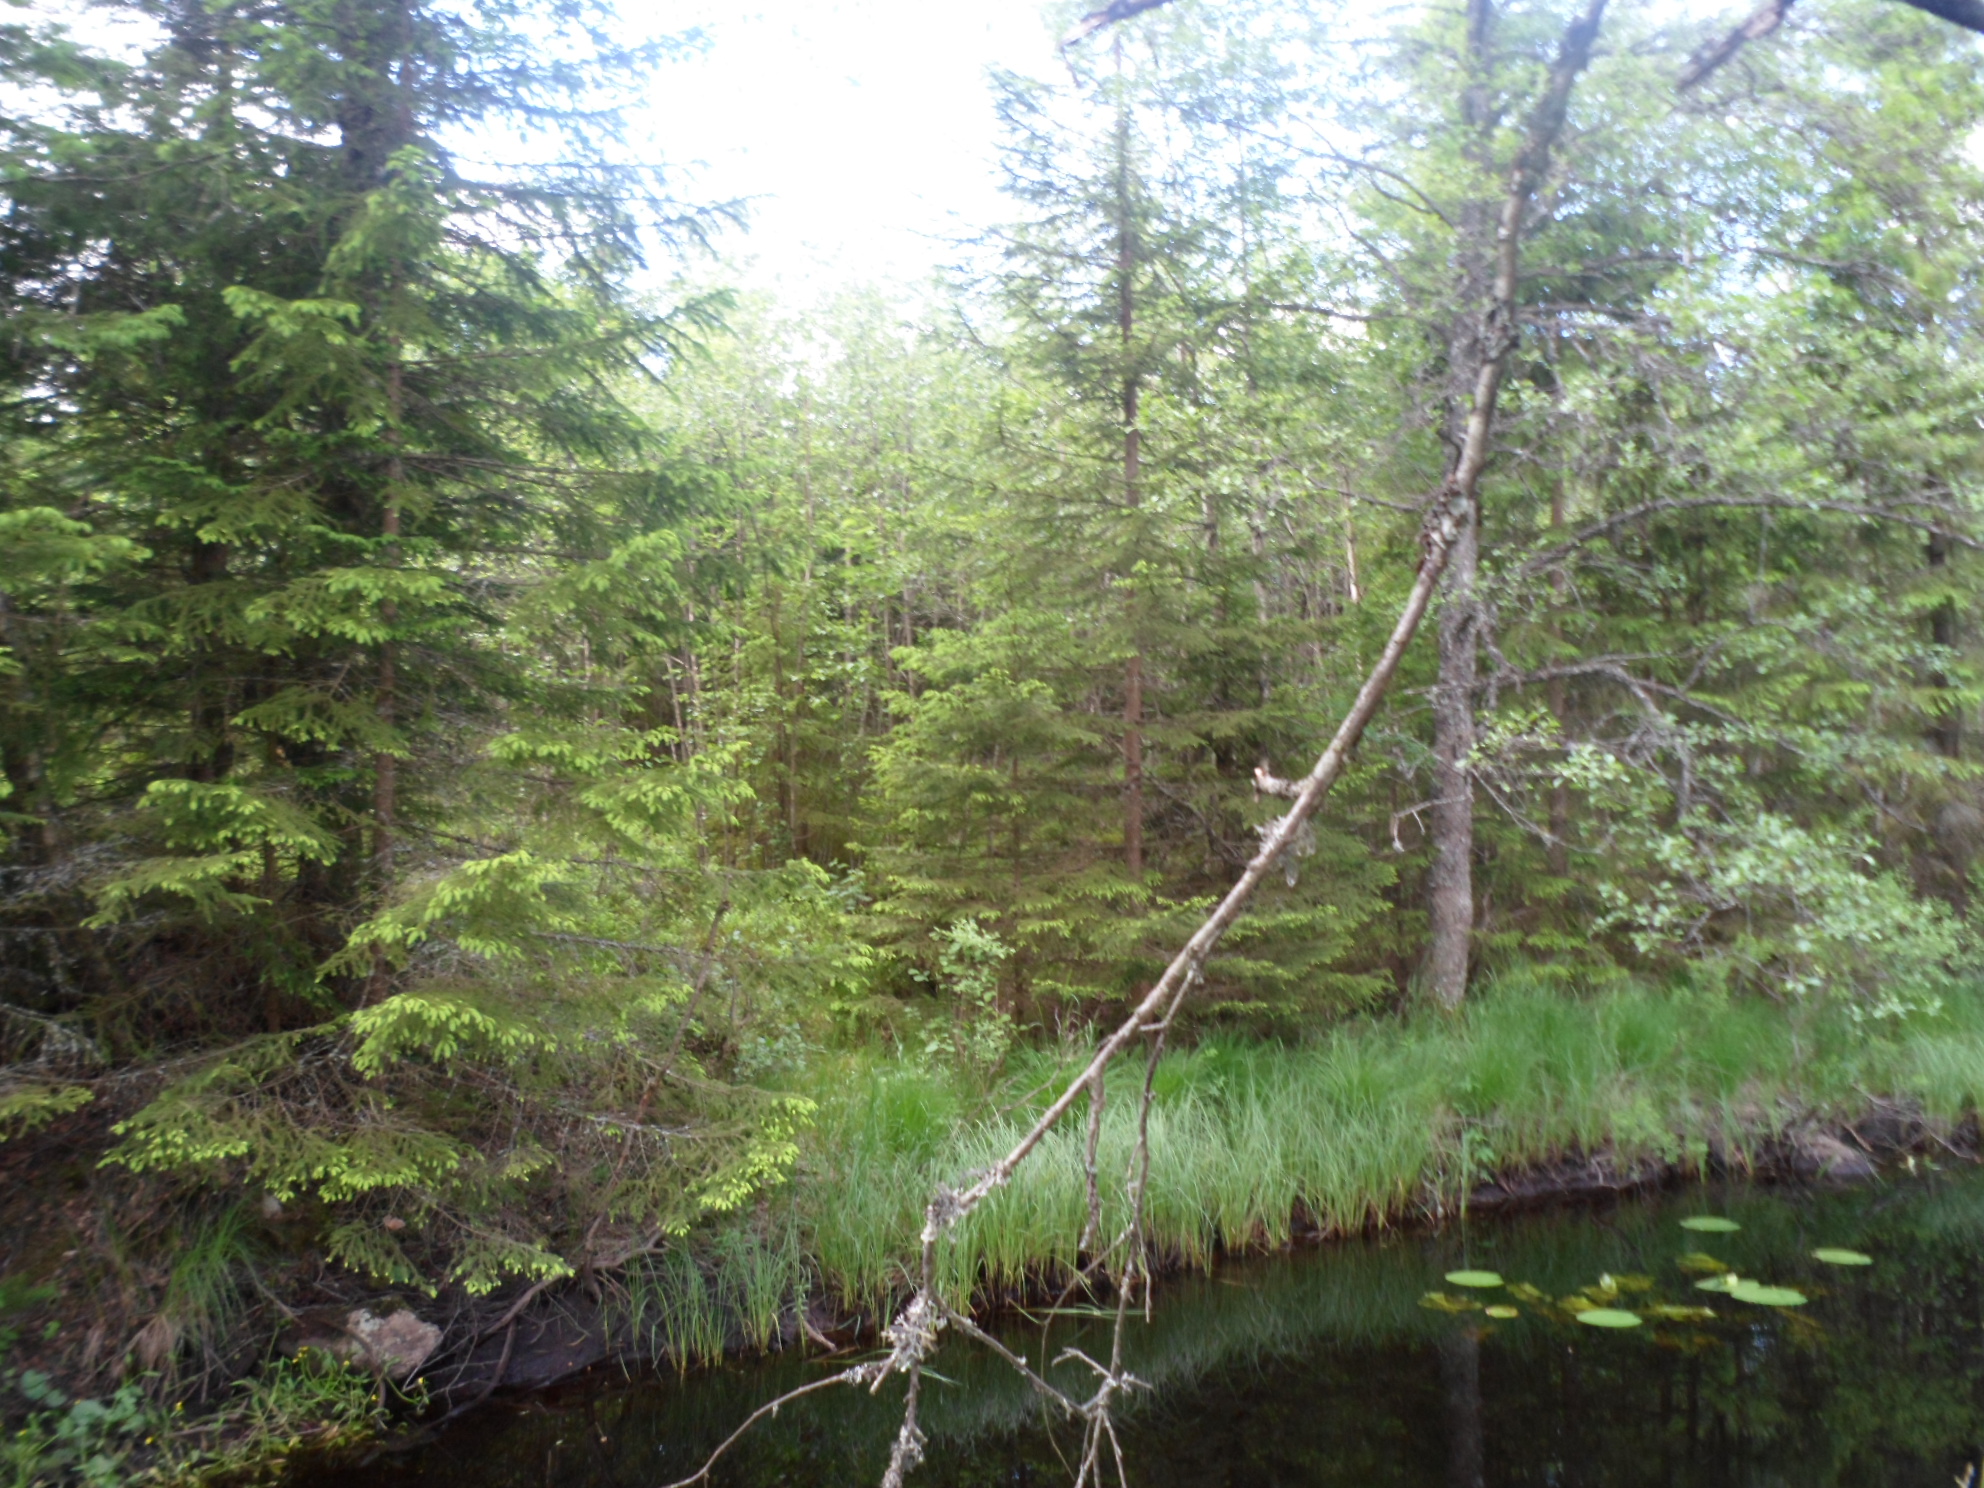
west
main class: Woodland
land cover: Spruce dominated mixed woodland
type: boreal forest
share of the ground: 25 - 50 %
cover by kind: broadleaved forest trees 30 %, coniferous forest trees 20 %, herbaceous plants 20 %, unconsolidated bare surface 20 %, shrubs 5 %, lichens and mosses 5 %
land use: Forestry
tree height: > 5 m
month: July
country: SE
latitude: 57.4603
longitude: 14.4797
